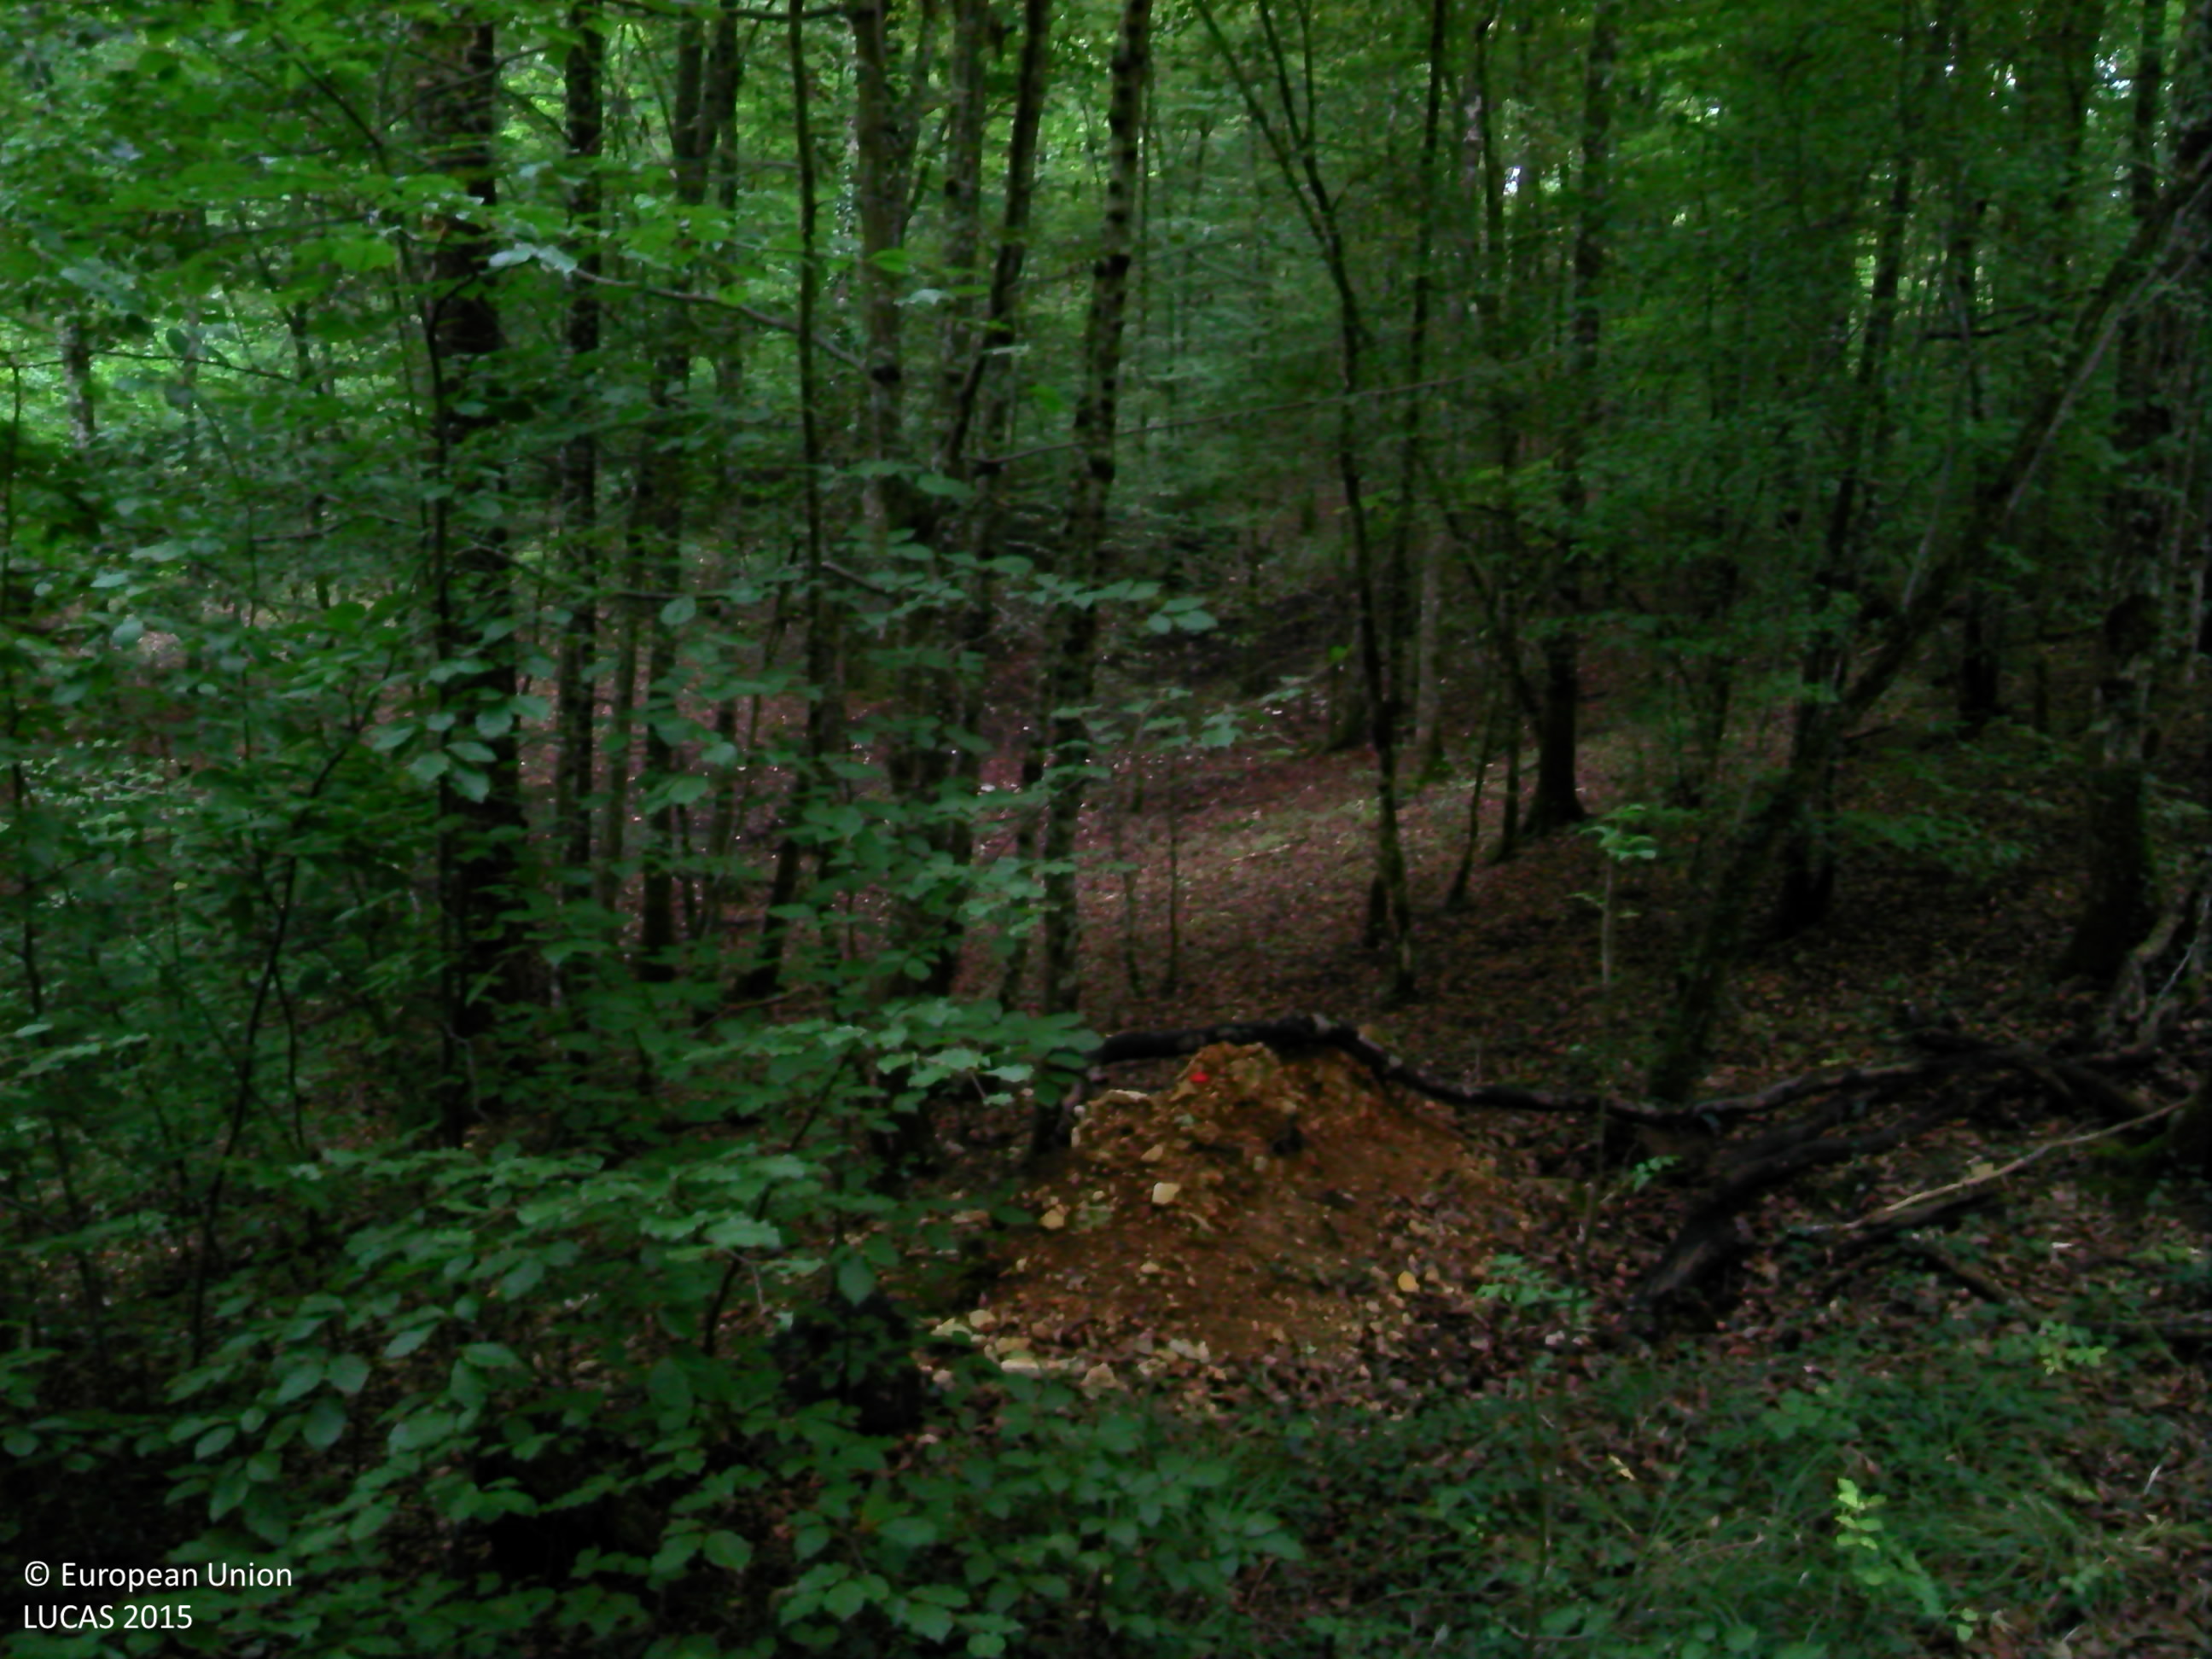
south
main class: Woodland
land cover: Broadleaved woodland
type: beech forest
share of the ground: > 75 %
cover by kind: broadleaved forest trees 85 %, herbaceous plants 10 %, shrubs 5 %
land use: Forestry
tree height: > 5 m
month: September
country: FR
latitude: 48.1919
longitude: 4.8193
